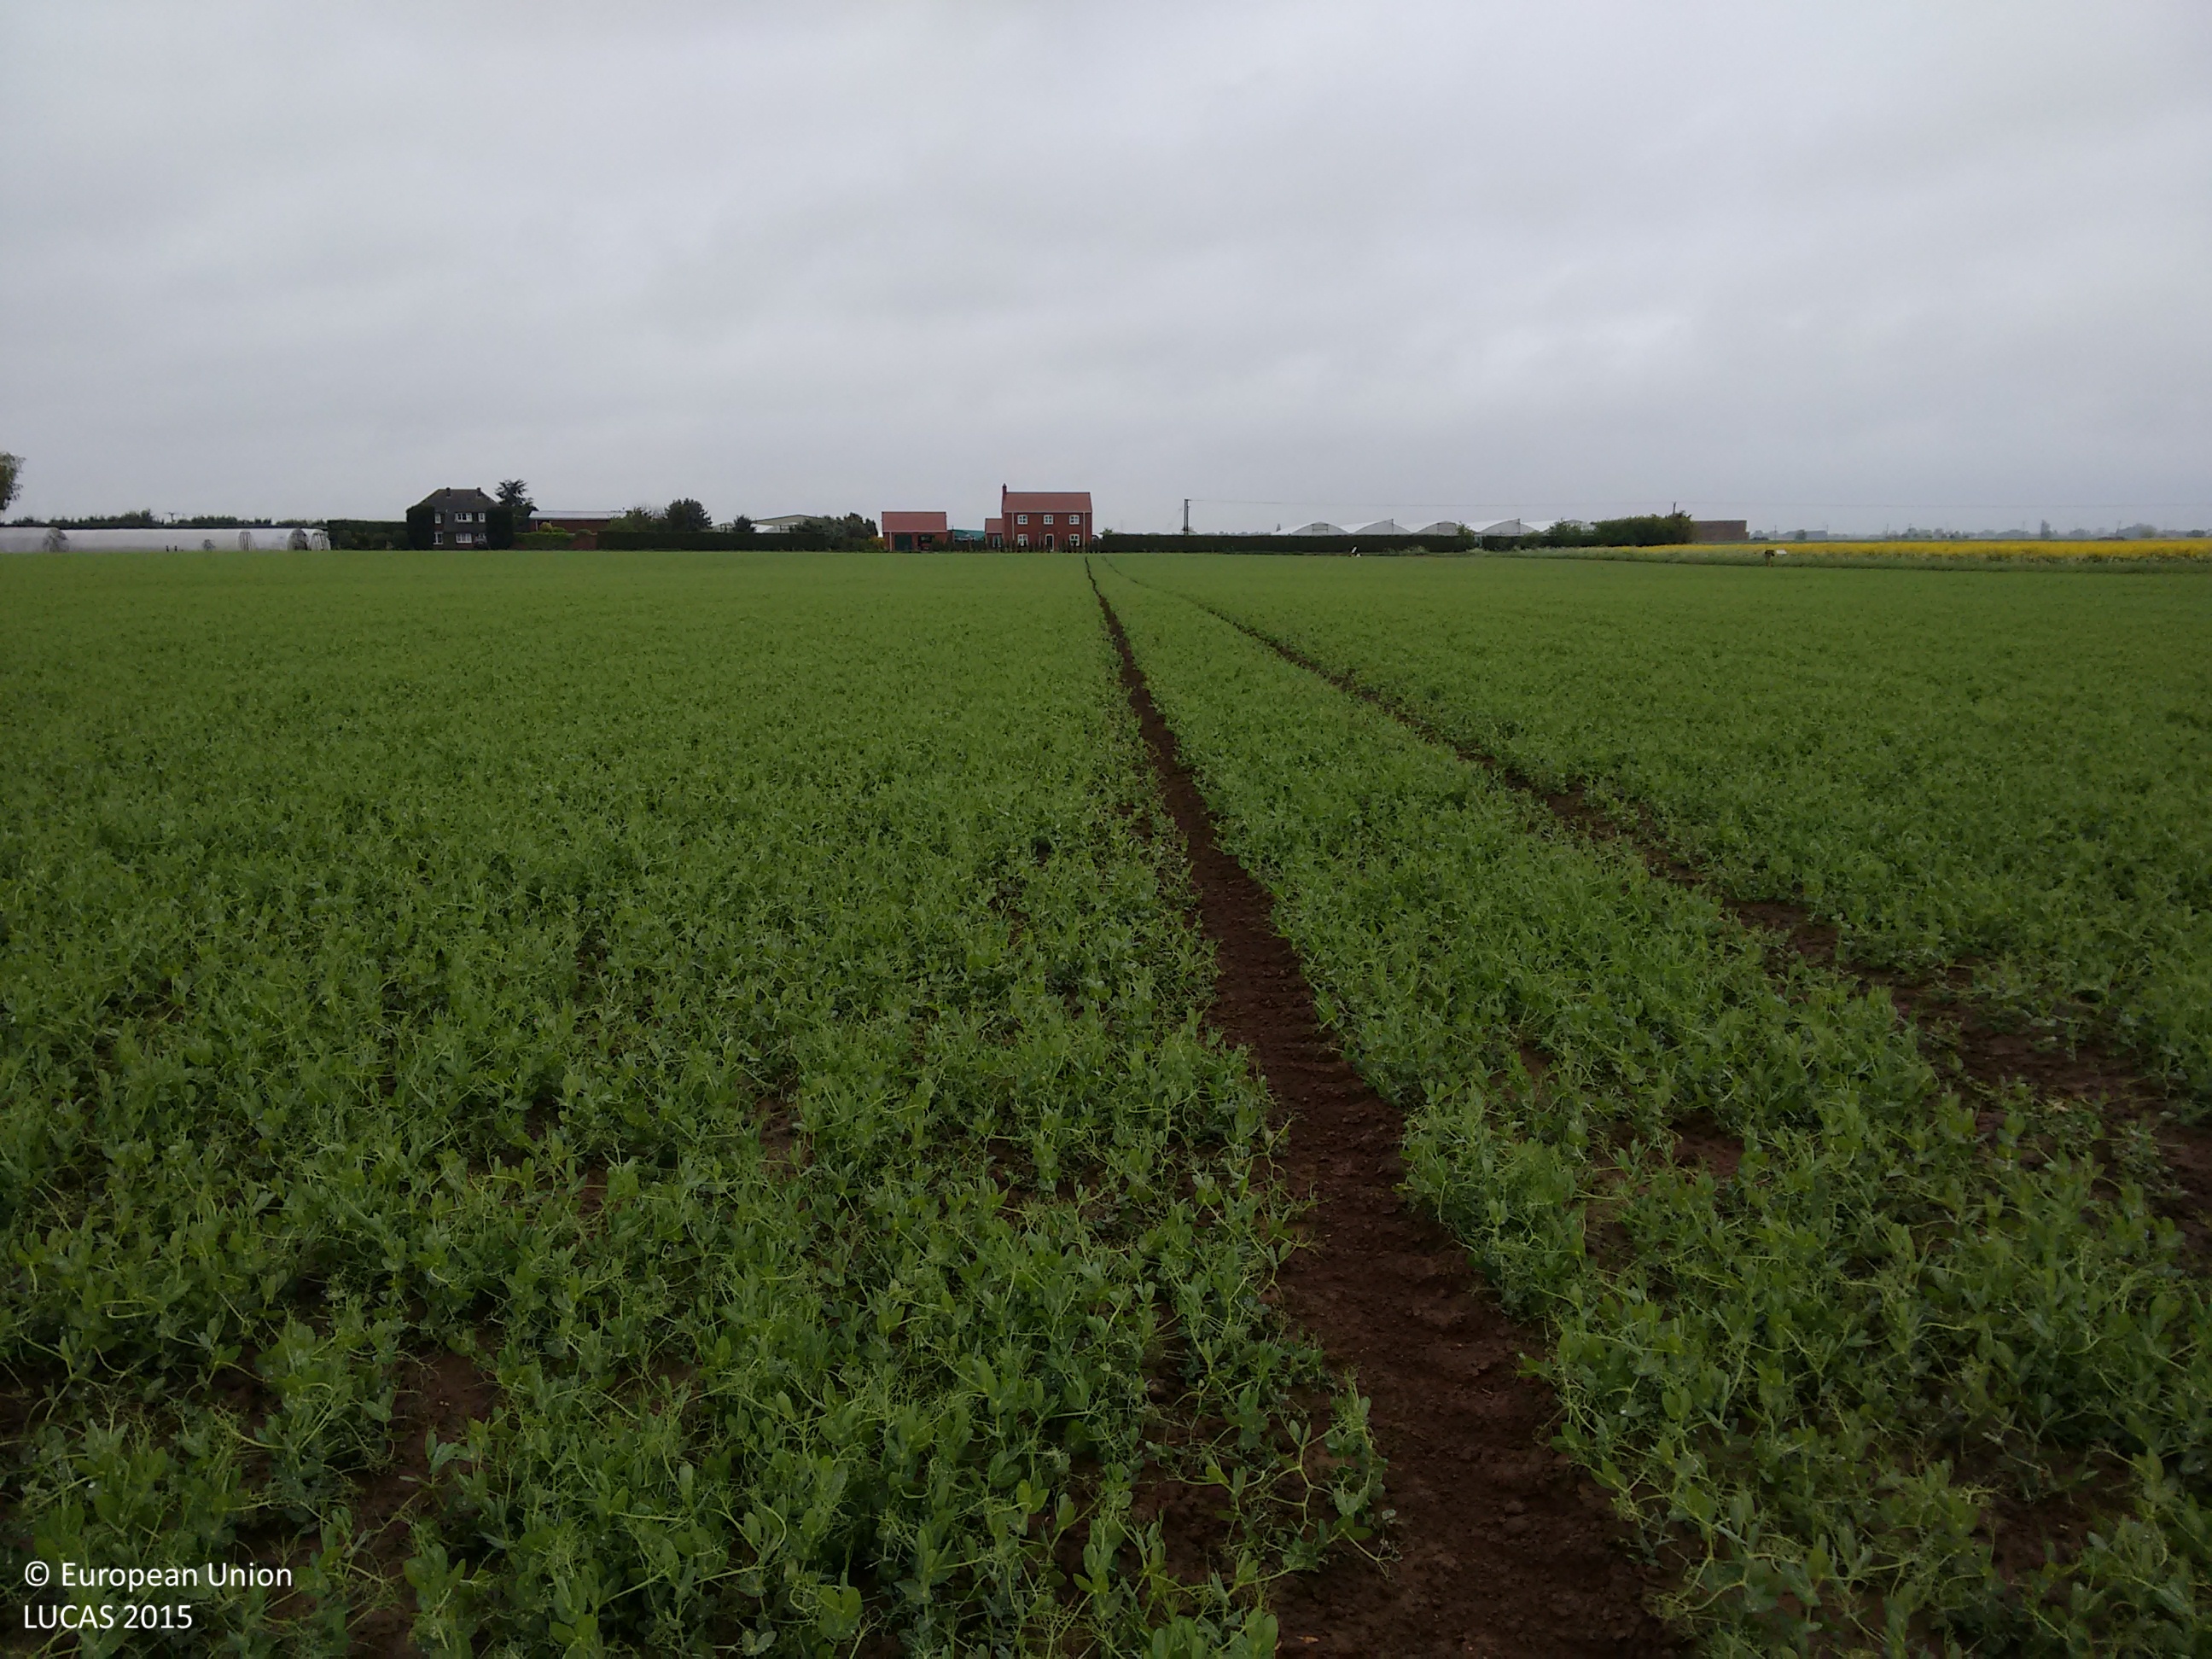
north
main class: Cropland
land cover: Dry pulses
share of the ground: 50 - 75 %
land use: Agriculture (excluding fallow land and kitchen gardens)
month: May
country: GB
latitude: 52.9215
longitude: -0.1328
